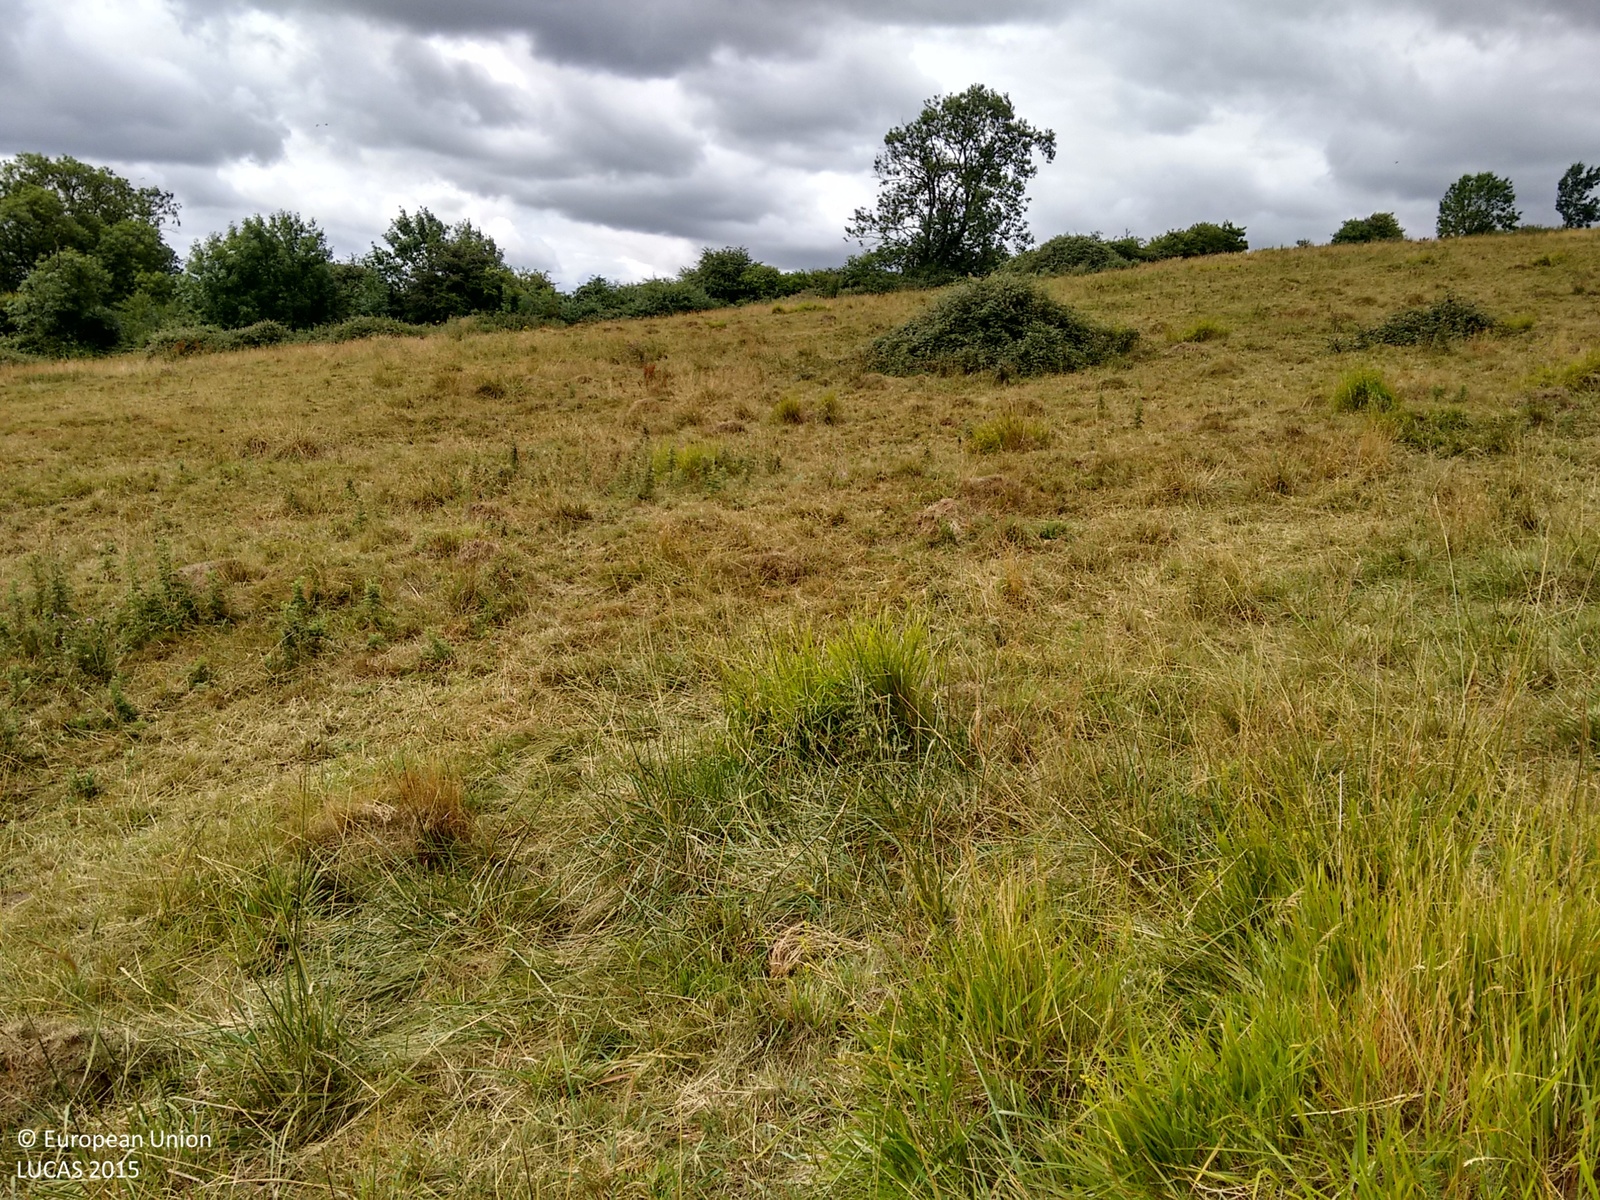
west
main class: Grassland
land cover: Grassland without tree/shrub cover
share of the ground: > 75 %
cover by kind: herbaceous plants 100 %
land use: Agriculture (excluding fallow land and kitchen gardens)
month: July
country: GB
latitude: 52.8459
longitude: -0.9866
